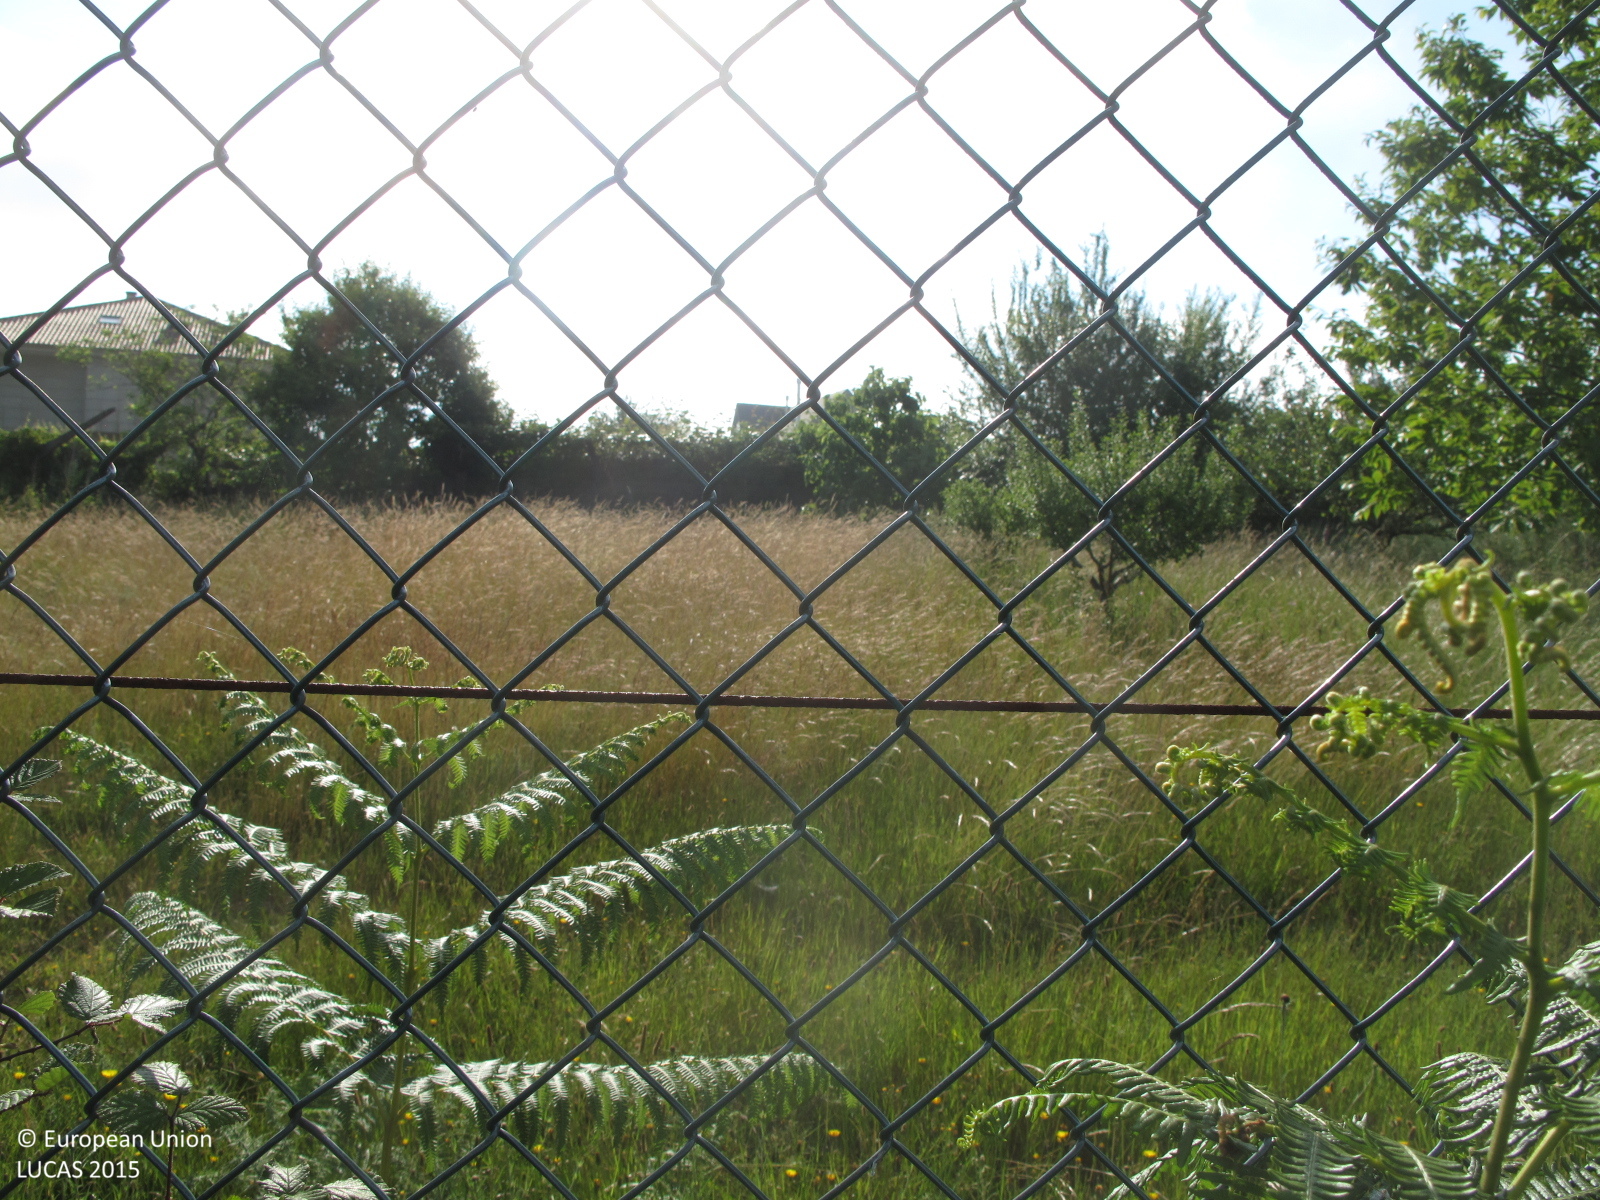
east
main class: Woodland
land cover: Broadleaved woodland
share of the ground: 10 - 25 %
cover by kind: herbaceous plants 85 %, broadleaved forest trees 15 %
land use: Residential
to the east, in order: Broadleaved woodland; Artificial constructions in urban areas; Dry stone walls; Maize; Grass margins; Paved roads, cycling and walking lanes; Grass margins; Conifer hedges; Fences; Broadleaved woodland
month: June
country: ES
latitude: 42.8937
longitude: -8.4838
